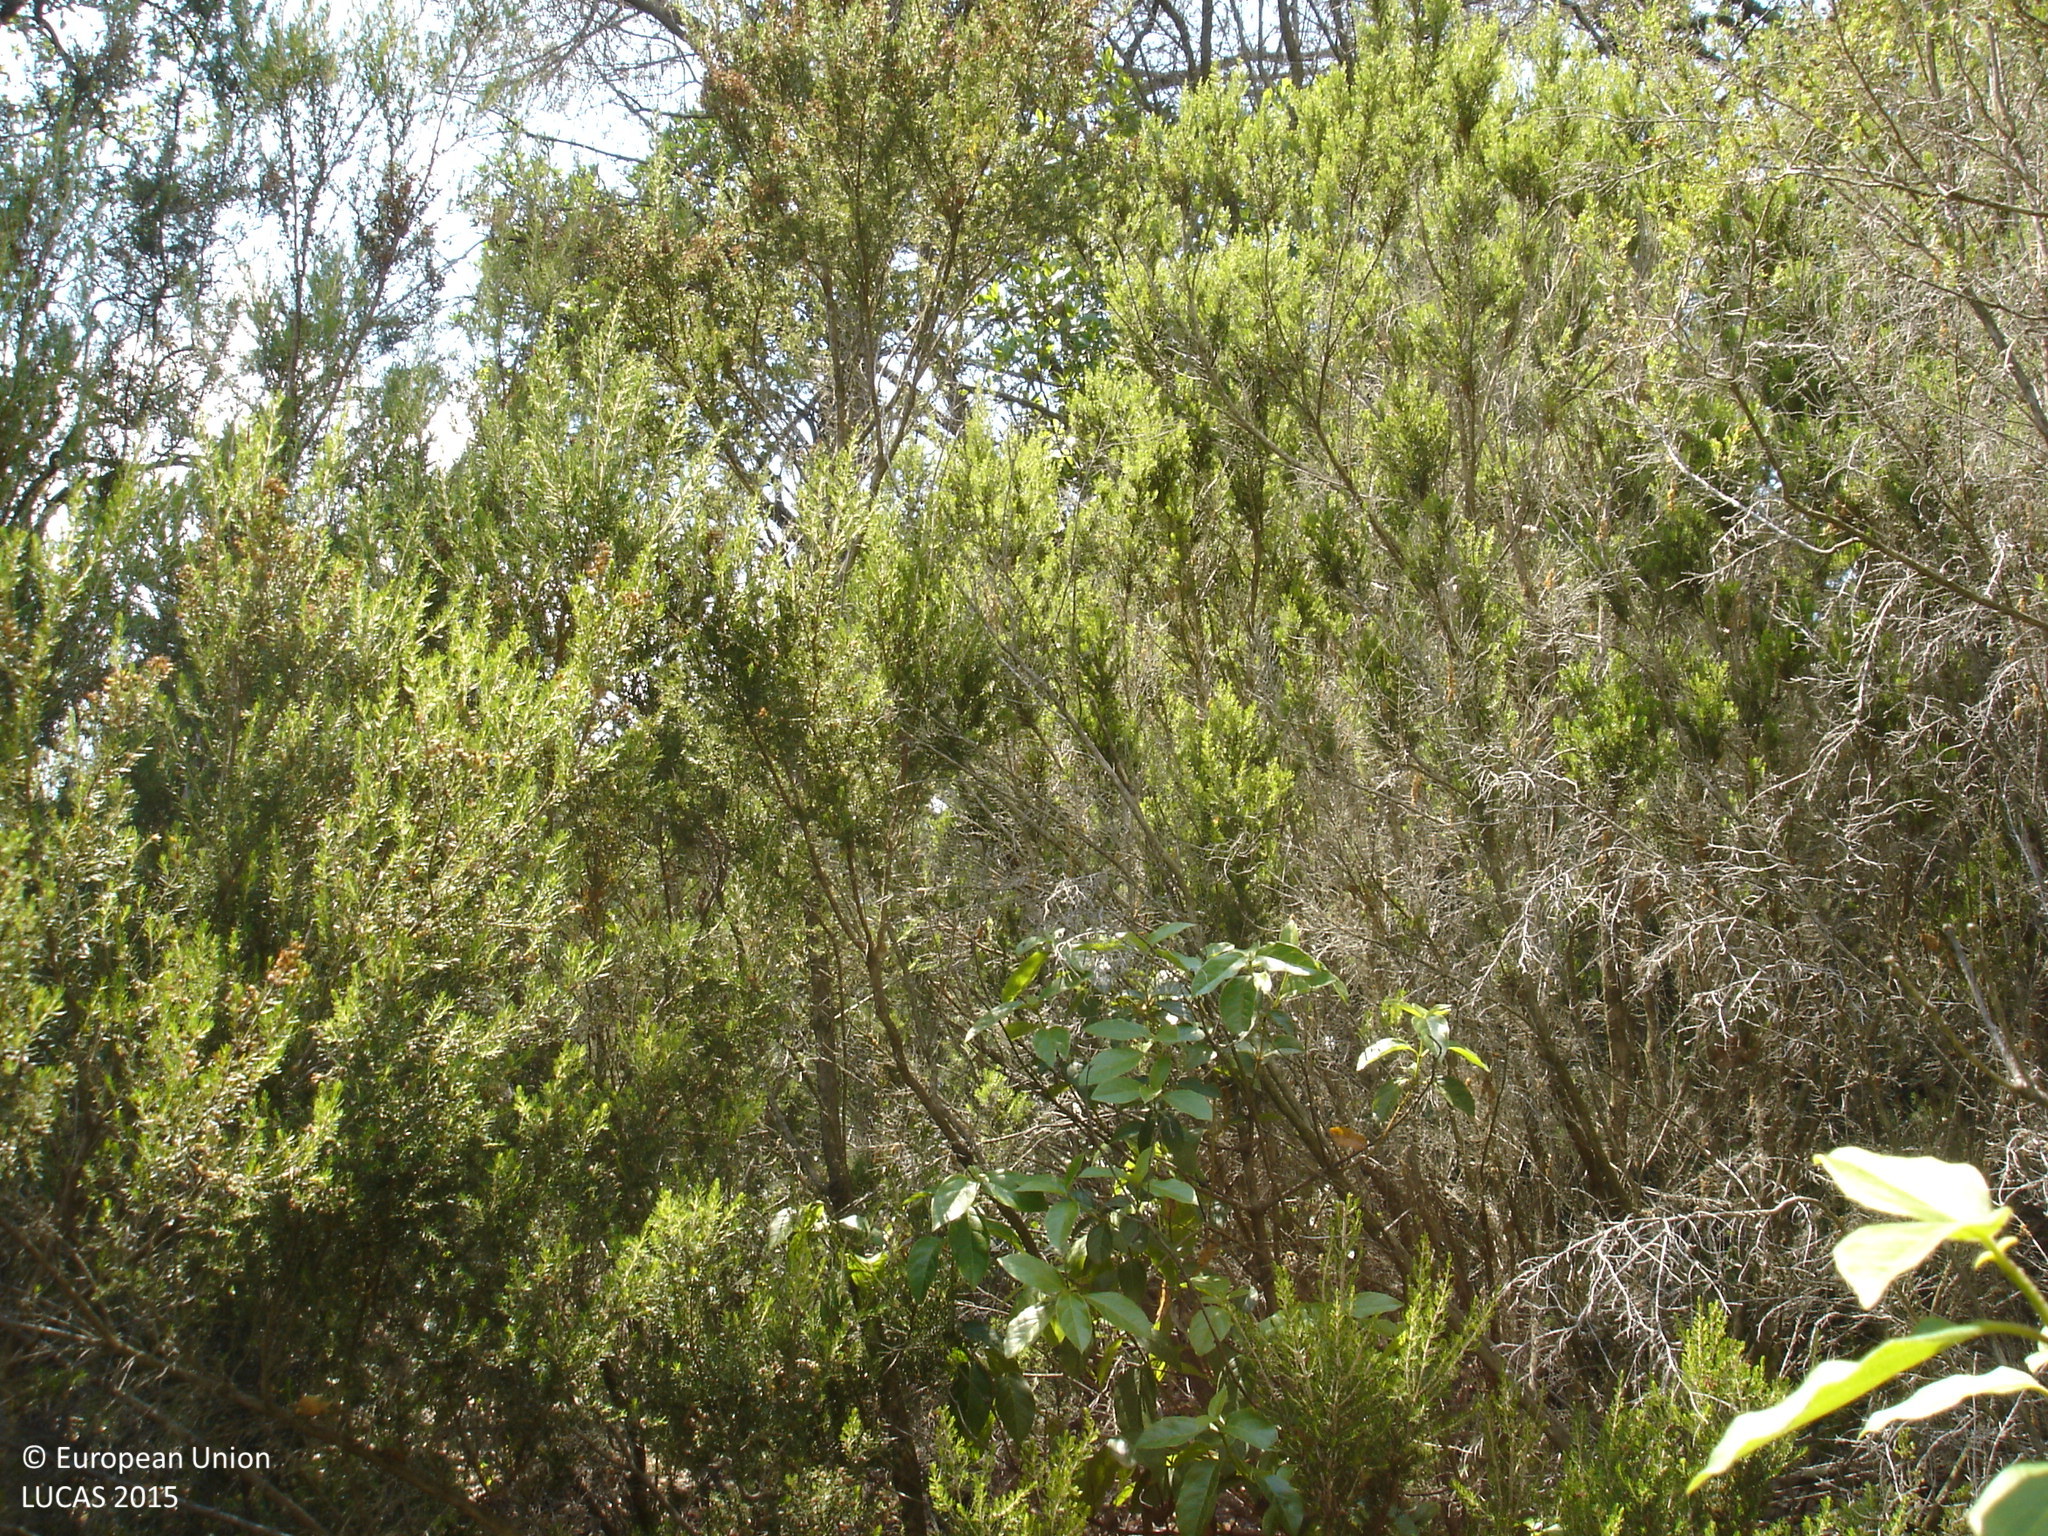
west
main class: Woodland
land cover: Other mixed woodland
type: thermophilous deciduous forest
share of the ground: > 75 %
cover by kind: coniferous forest trees 40 %, broadleaved forest trees 40 %, shrubs 15 %, herbaceous plants 5 %
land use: Forestry
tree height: > 5 m
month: June
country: ES
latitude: 41.7122
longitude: 2.6012
